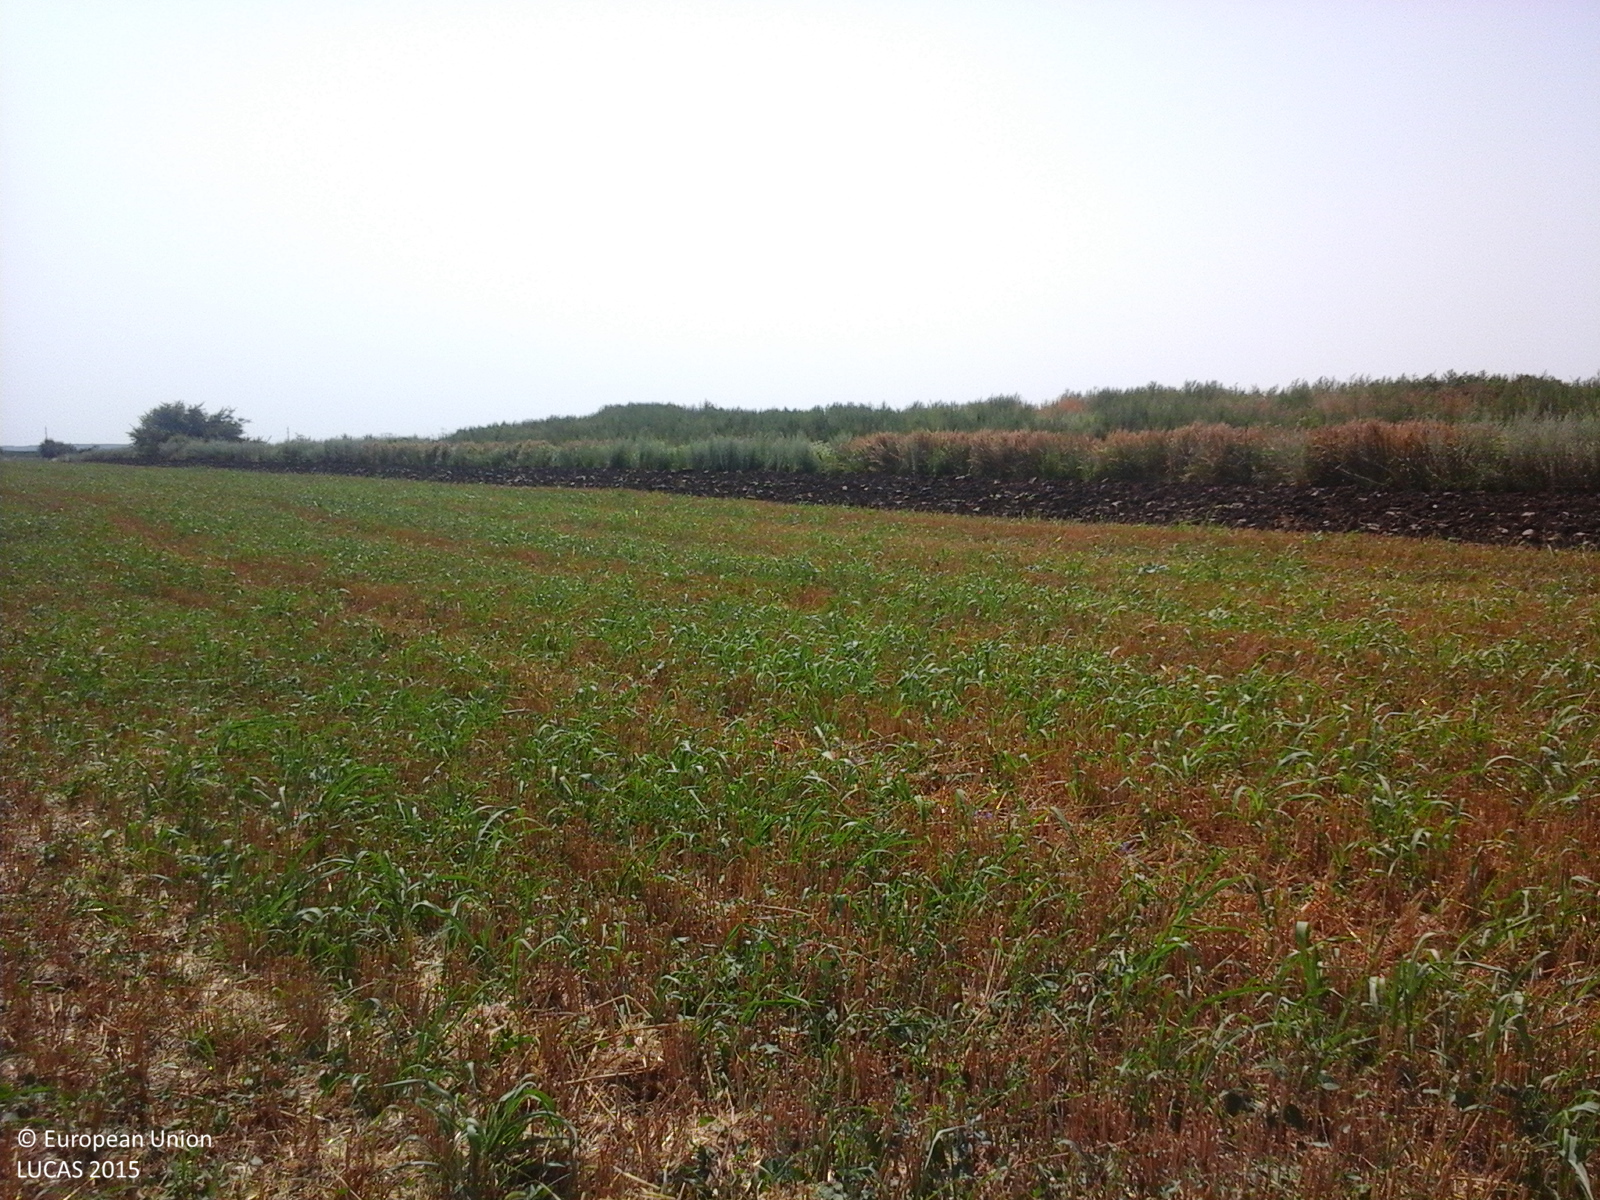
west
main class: Cropland
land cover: Durum wheat
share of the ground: 25 - 50 %
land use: Agriculture (excluding fallow land and kitchen gardens)
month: July
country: RO
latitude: 44.5375
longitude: 26.5406
